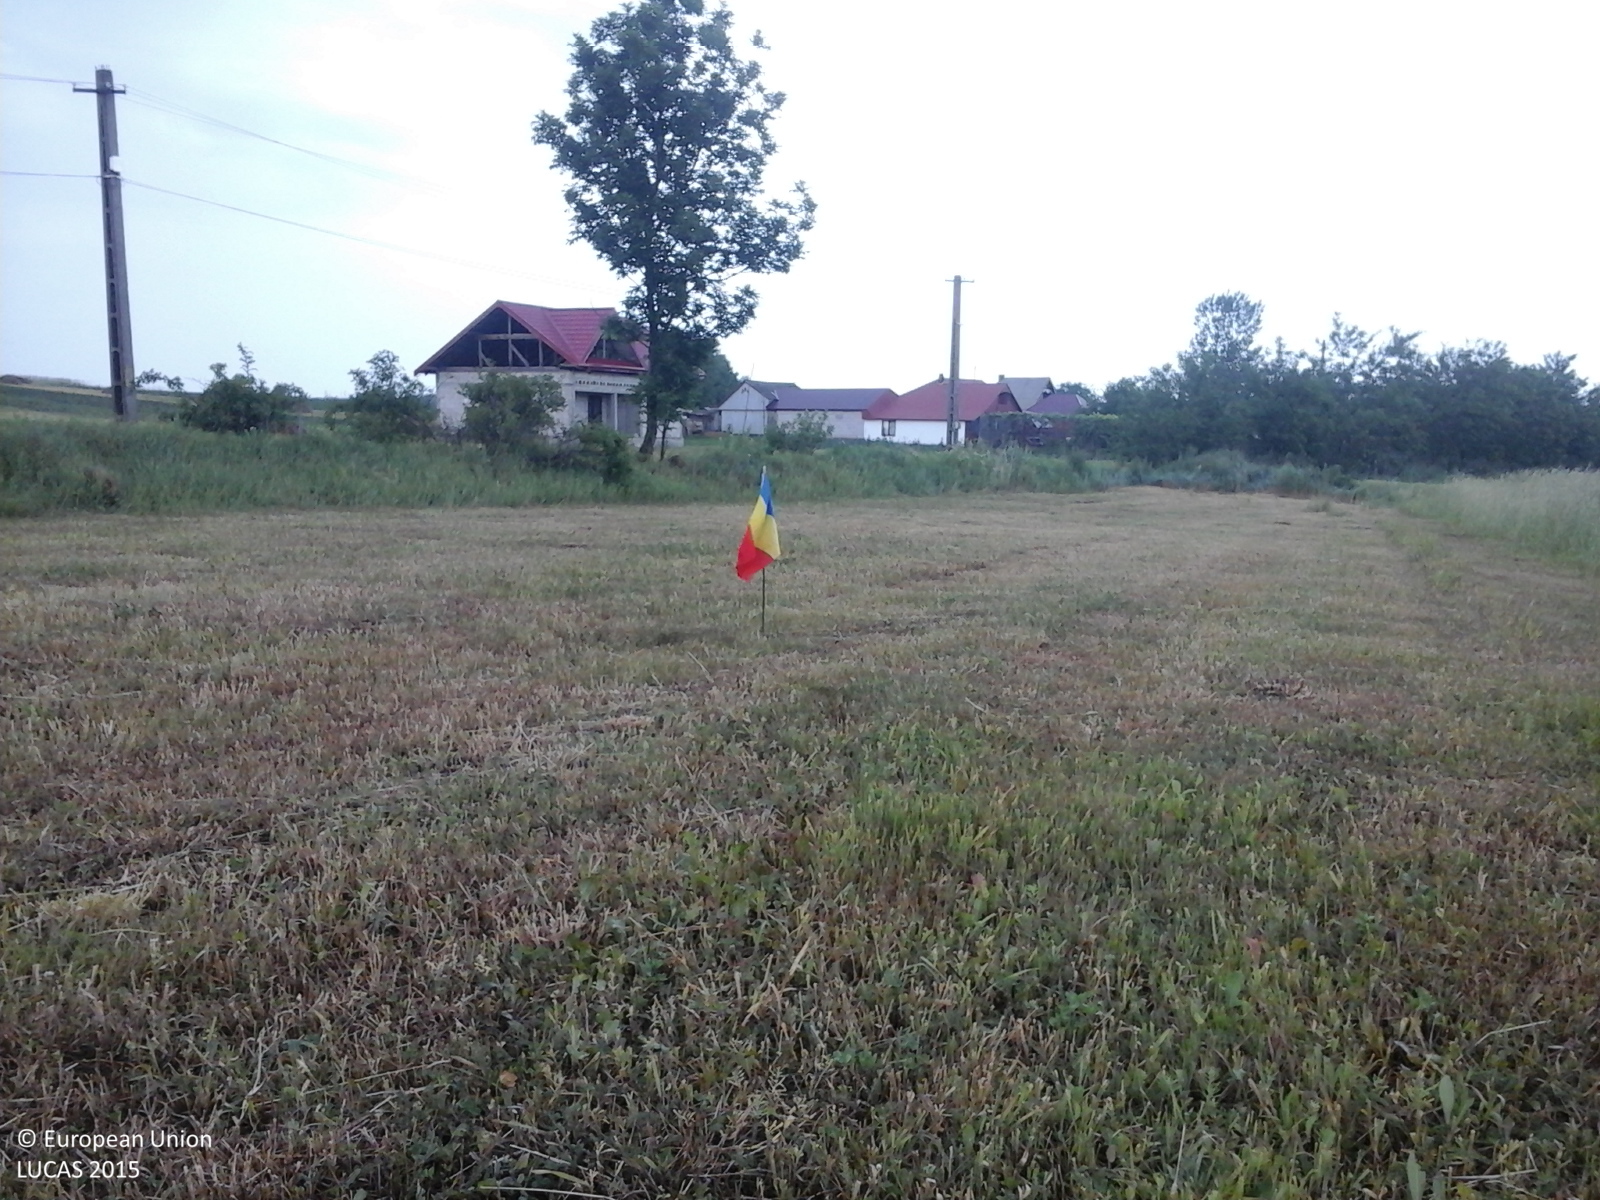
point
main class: Cropland
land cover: Other leguminous and mixtures for fodder
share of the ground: > 75 %
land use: Agriculture (excluding fallow land and kitchen gardens)
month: June
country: RO
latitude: 47.4067
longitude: 26.3985
